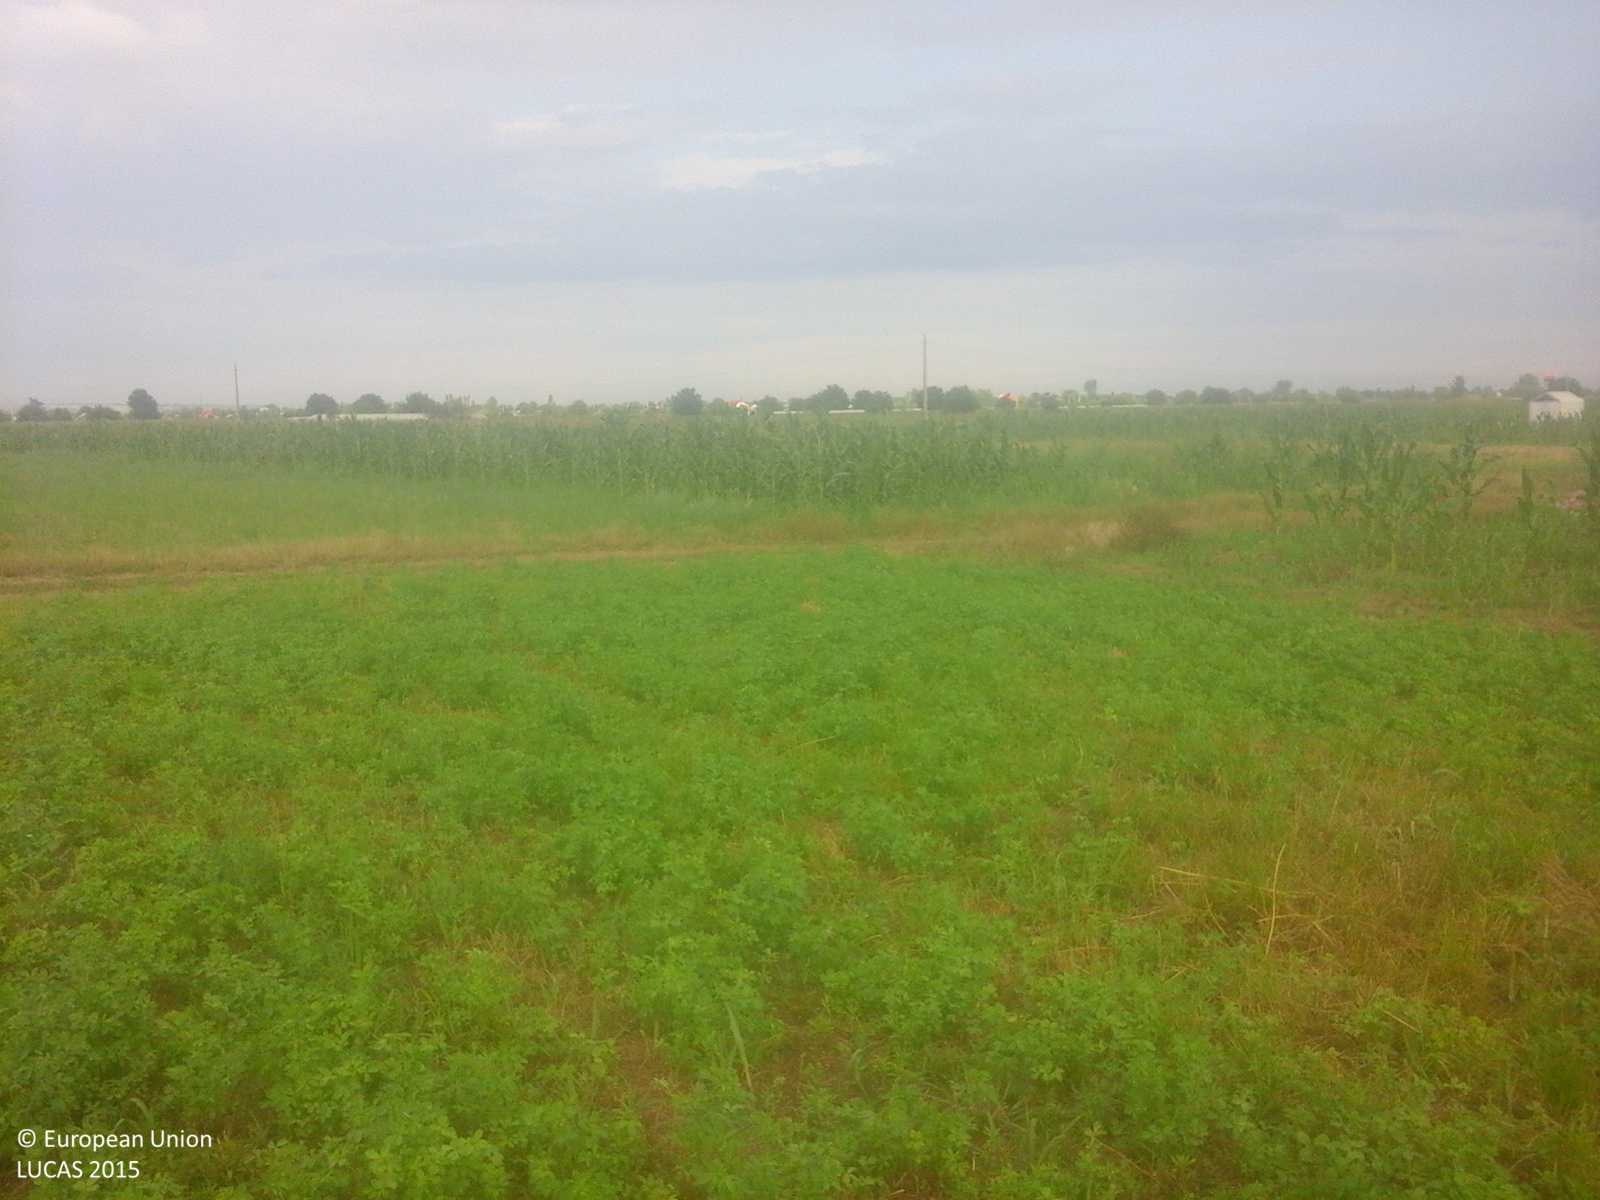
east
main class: Cropland
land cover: Lucerne
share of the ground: > 75 %
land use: Agriculture (excluding fallow land and kitchen gardens)
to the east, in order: Lucerne; Tracks; Oats; Maize; Spontaneously vegetated surfaces; Common wheat; Spontaneously vegetated surfaces; Lucerne; Maize; Electric lines; Maize; Grass margins; Tracks; Grass margins; Spontaneously vegetated surfaces; Maize
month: July
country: RO
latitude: 43.8766
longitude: 24.6158
